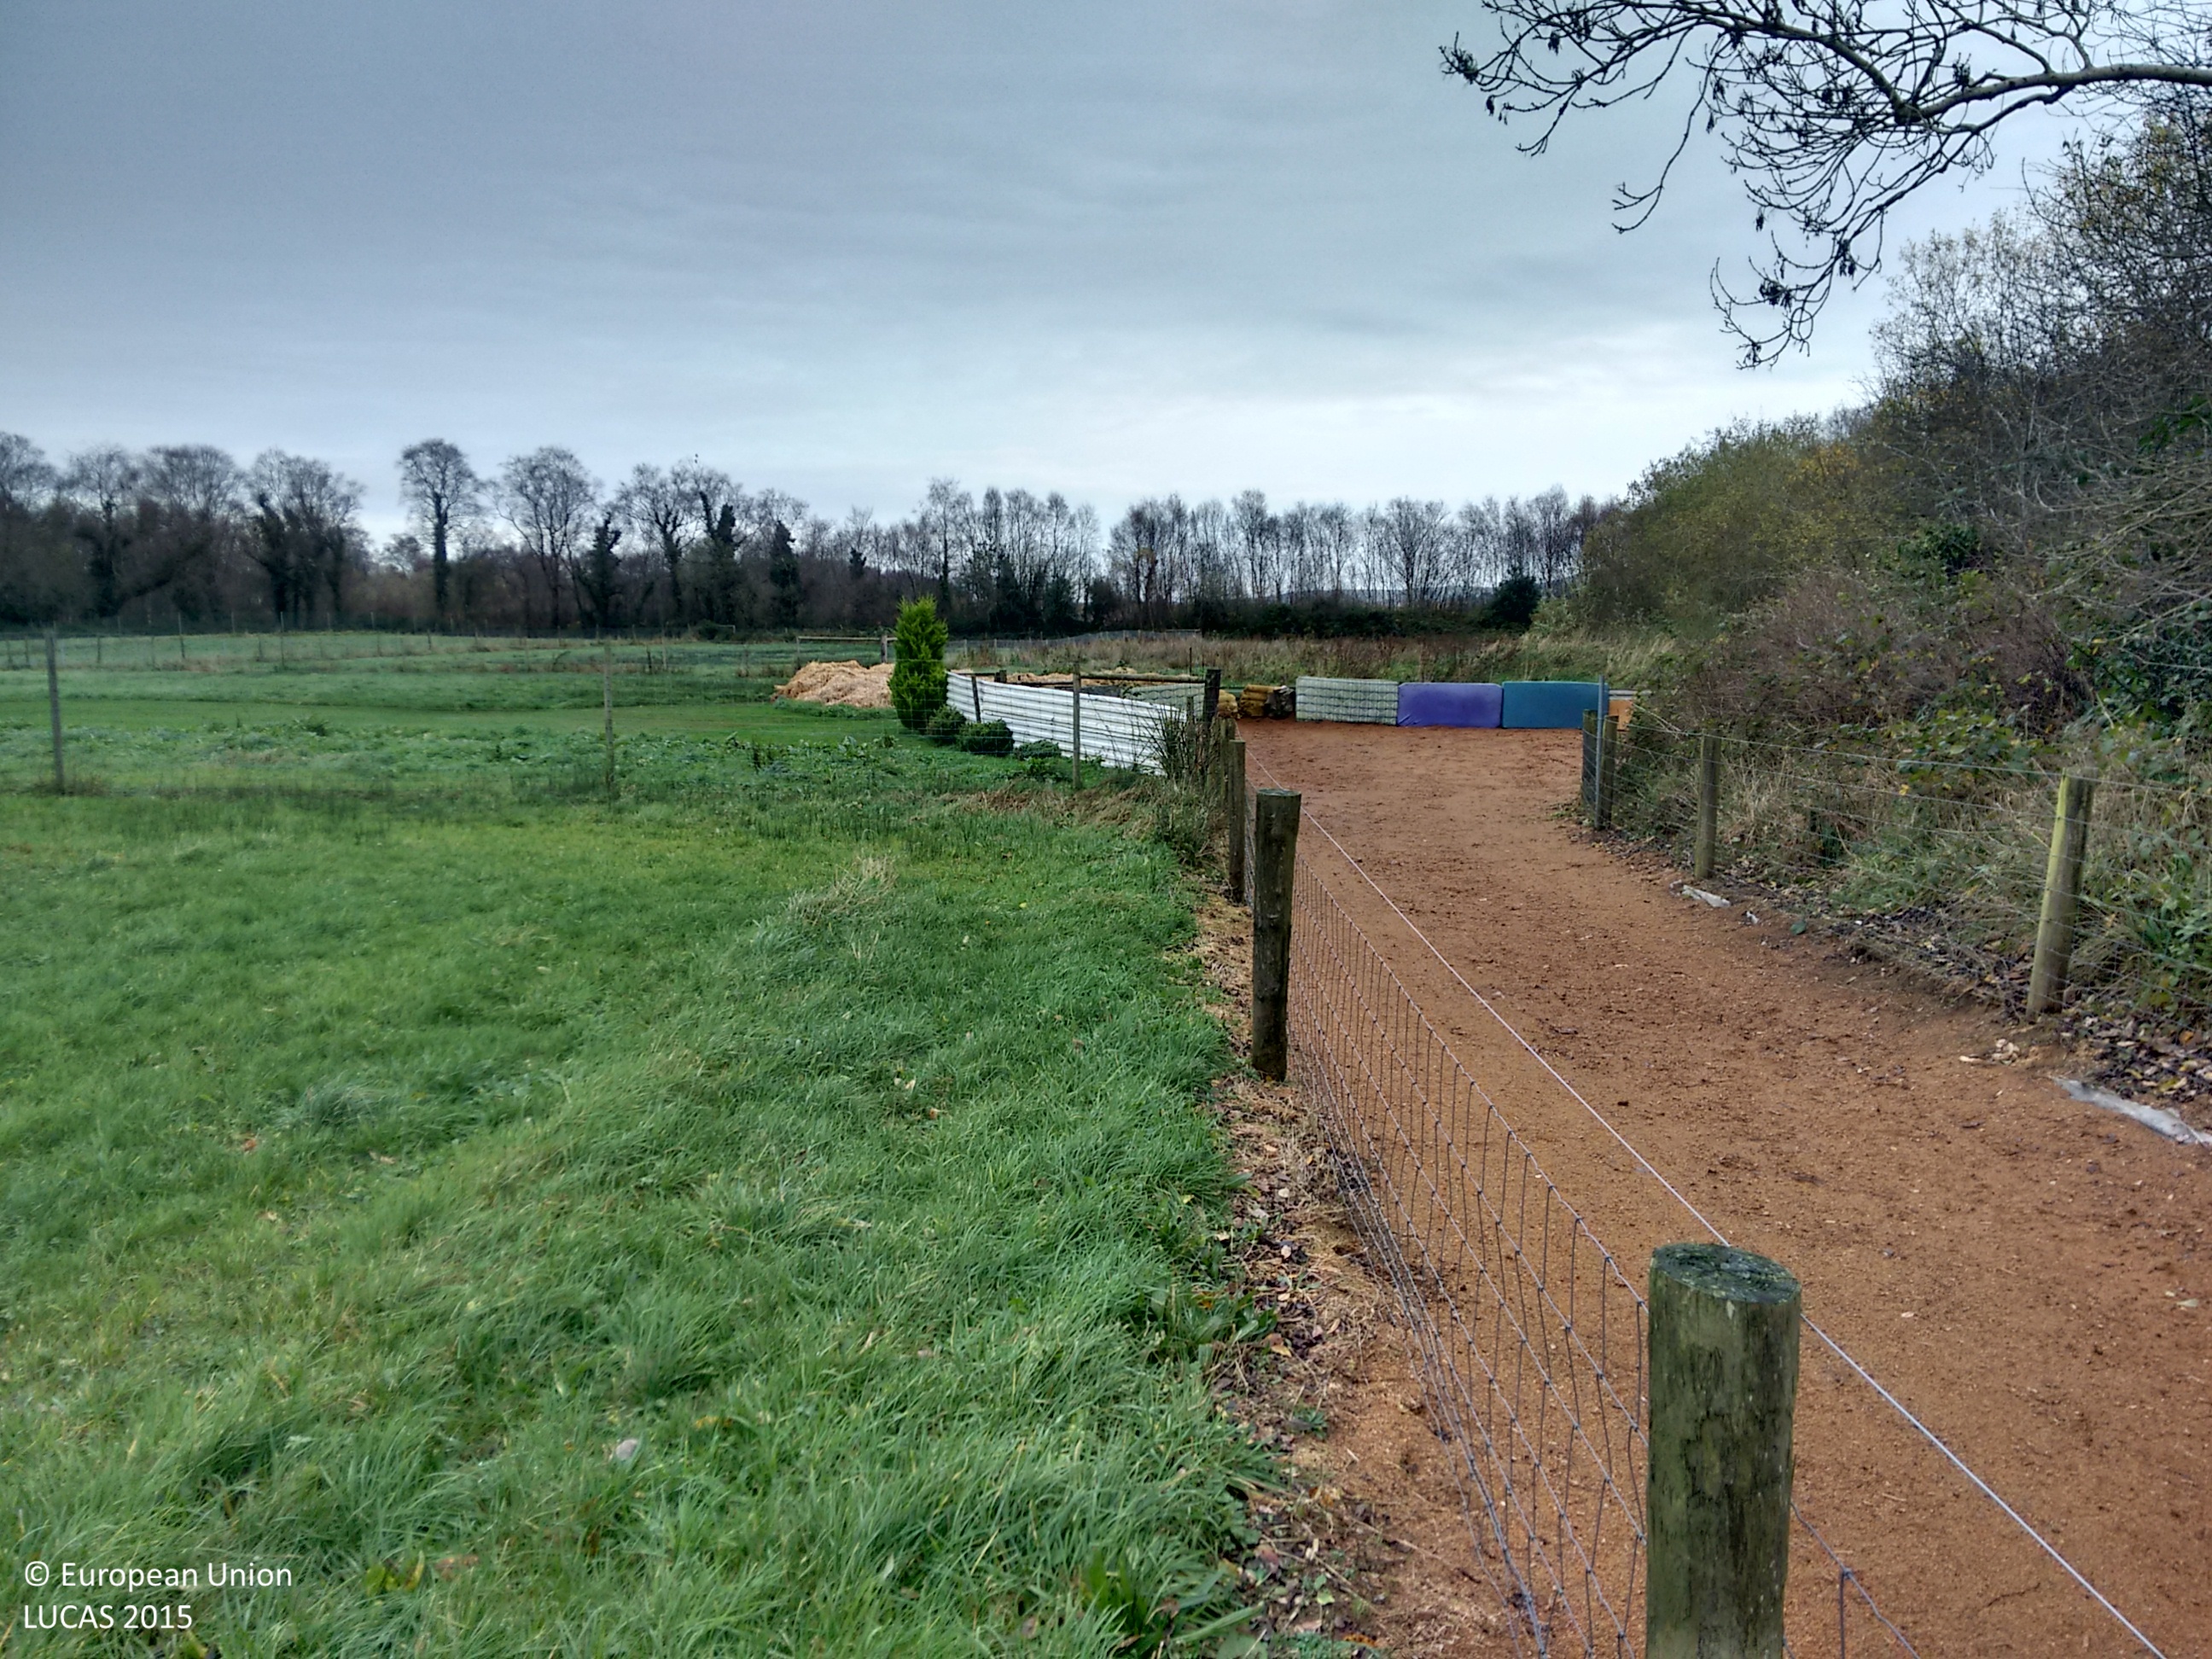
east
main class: Woodland
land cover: Broadleaved woodland
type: acidophilous oak and oak-birch forest
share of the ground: > 75 %
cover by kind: broadleaved forest trees 95 %, herbaceous plants 5 %
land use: Semi-natural and natural areas not in use
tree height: > 5 m
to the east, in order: Broadleaved woodland; Fences; Other bare soil; Fences; Grassland without tree/shrub cover; Fences; Grassland without tree/shrub cover; Fences; Abandoned hedges; Ditches and canals; Abandoned hedges; Peatbogs
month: November
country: IE
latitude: 53.8191
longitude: -7.8031
